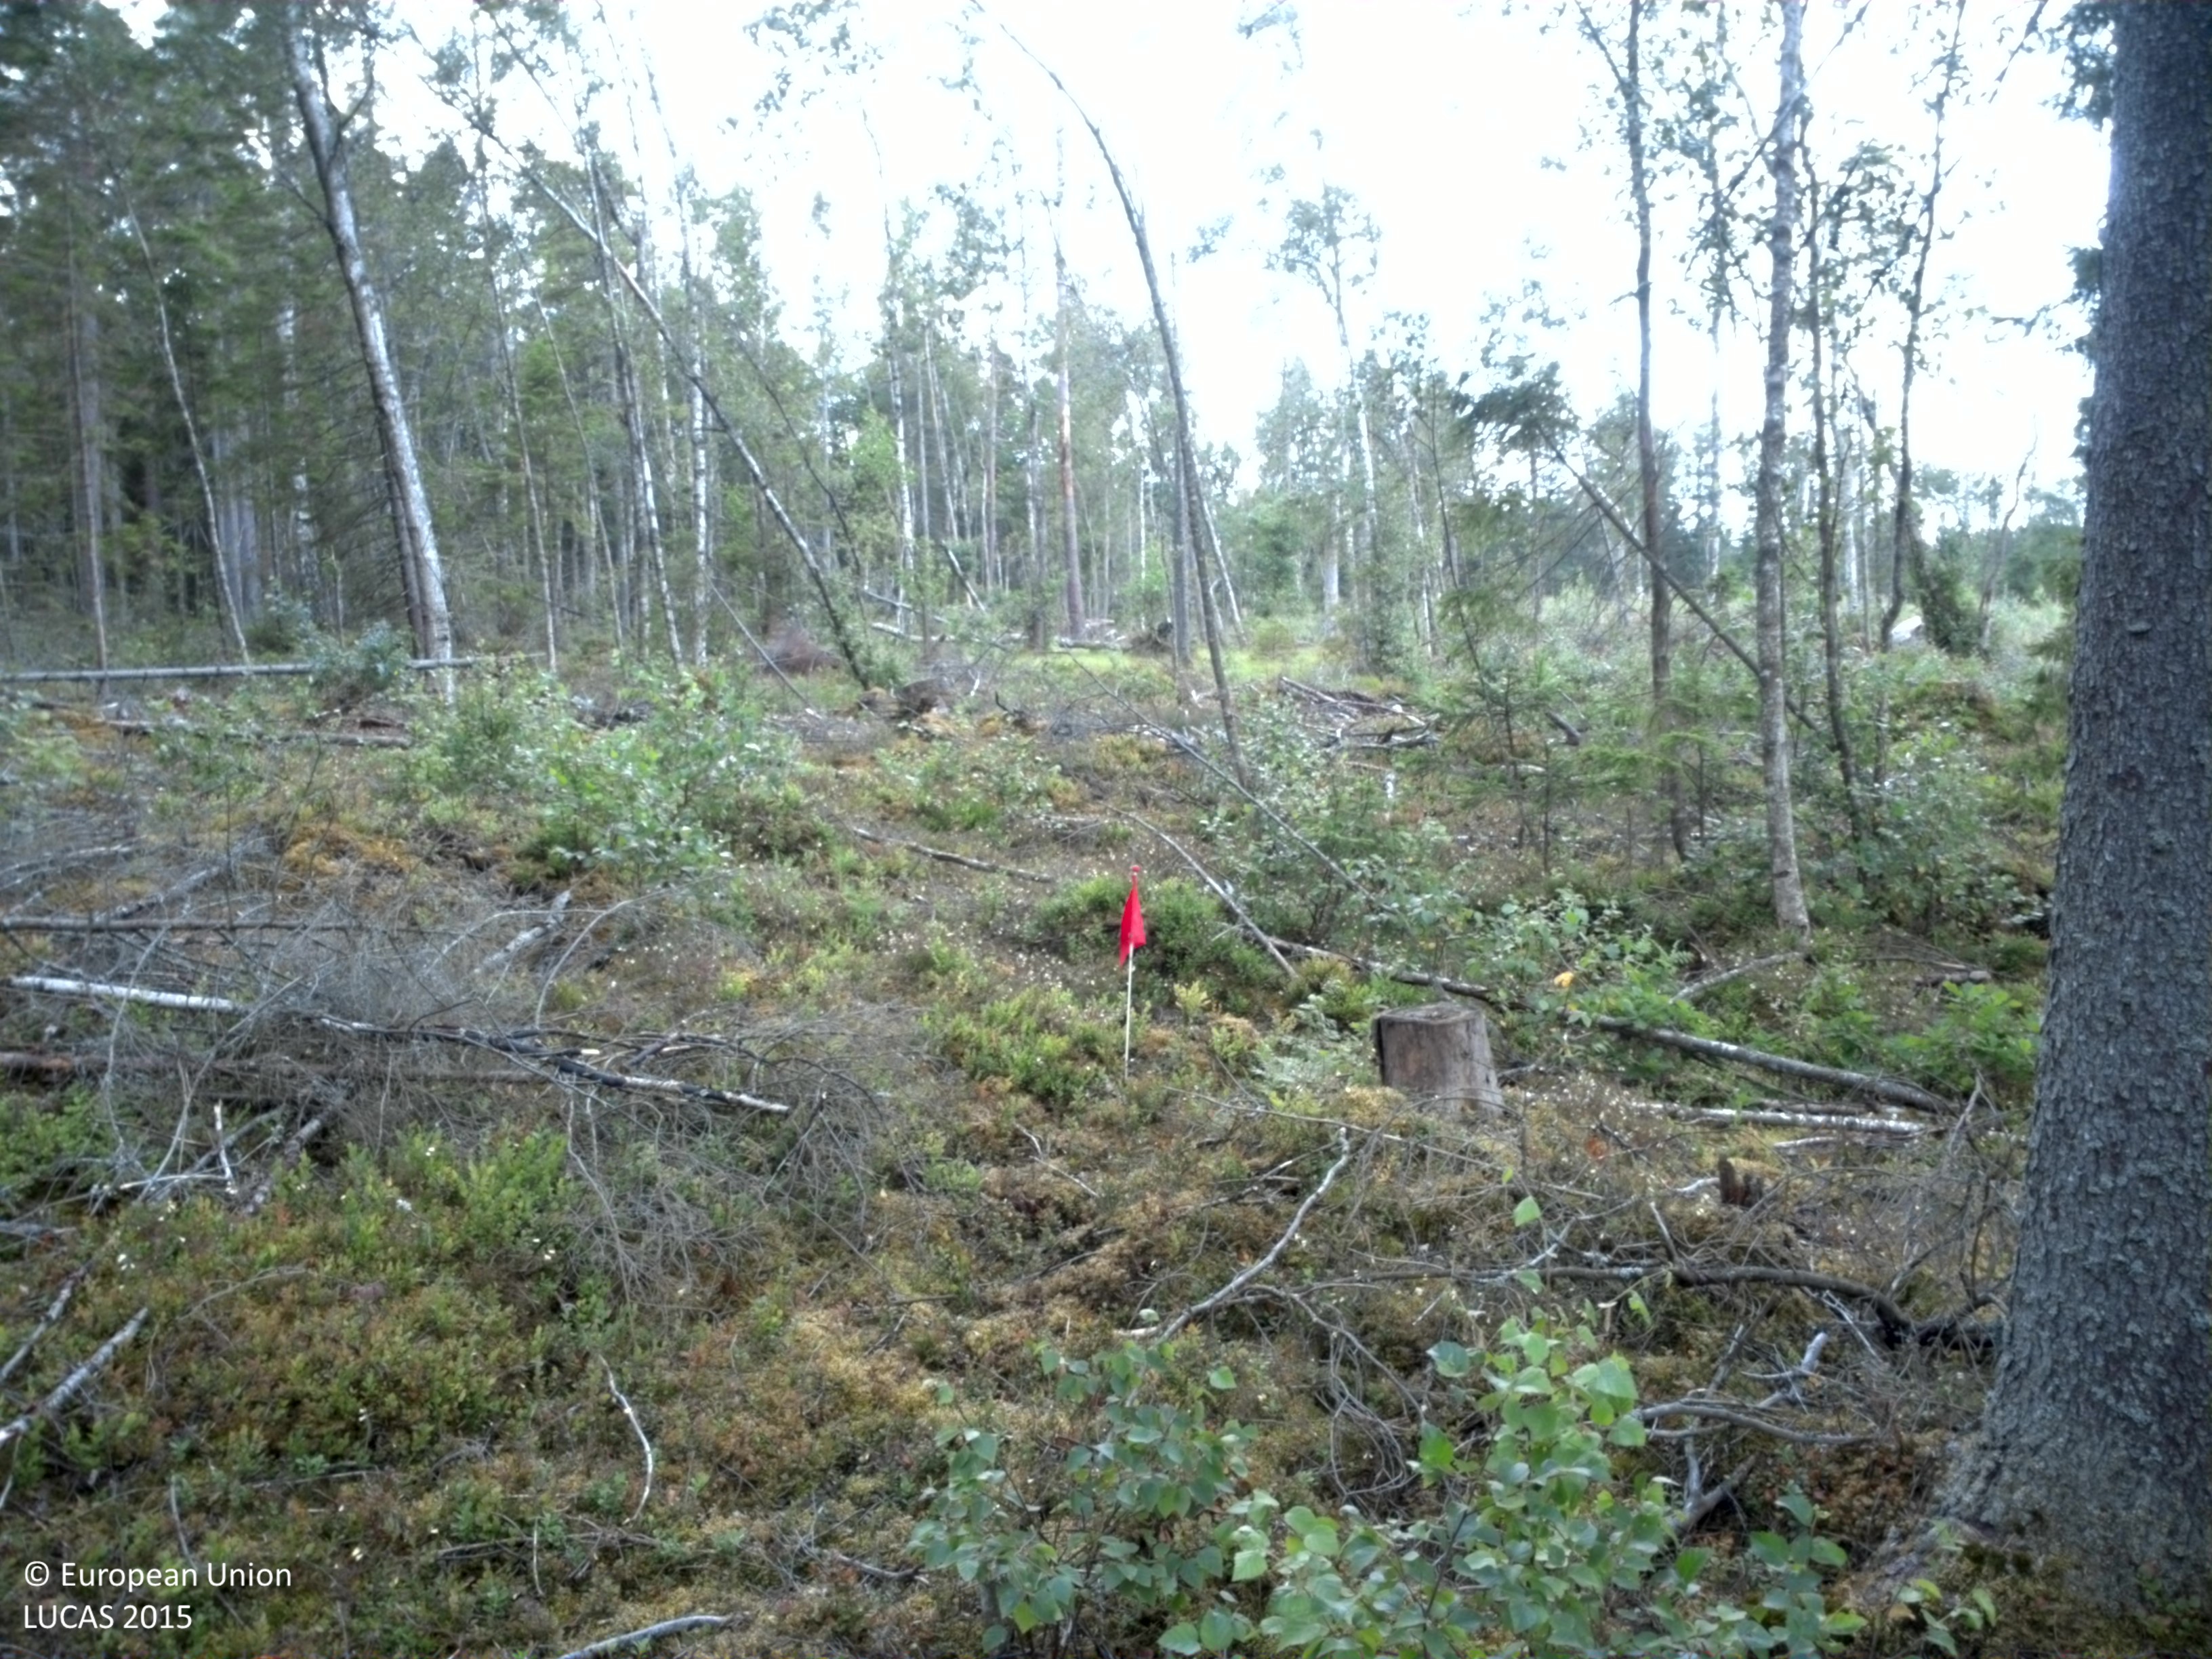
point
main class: Woodland
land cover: Spruce dominated coniferous woodland
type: boreal forest
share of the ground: 10 - 25 %
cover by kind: lichens and mosses 40 %, shrubs 25 %, coniferous forest trees 20 %, unconsolidated bare surface 10 %, broadleaved forest trees 5 %
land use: Forestry
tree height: > 5 m
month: July
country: SE
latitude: 58.7020
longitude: 13.9453
